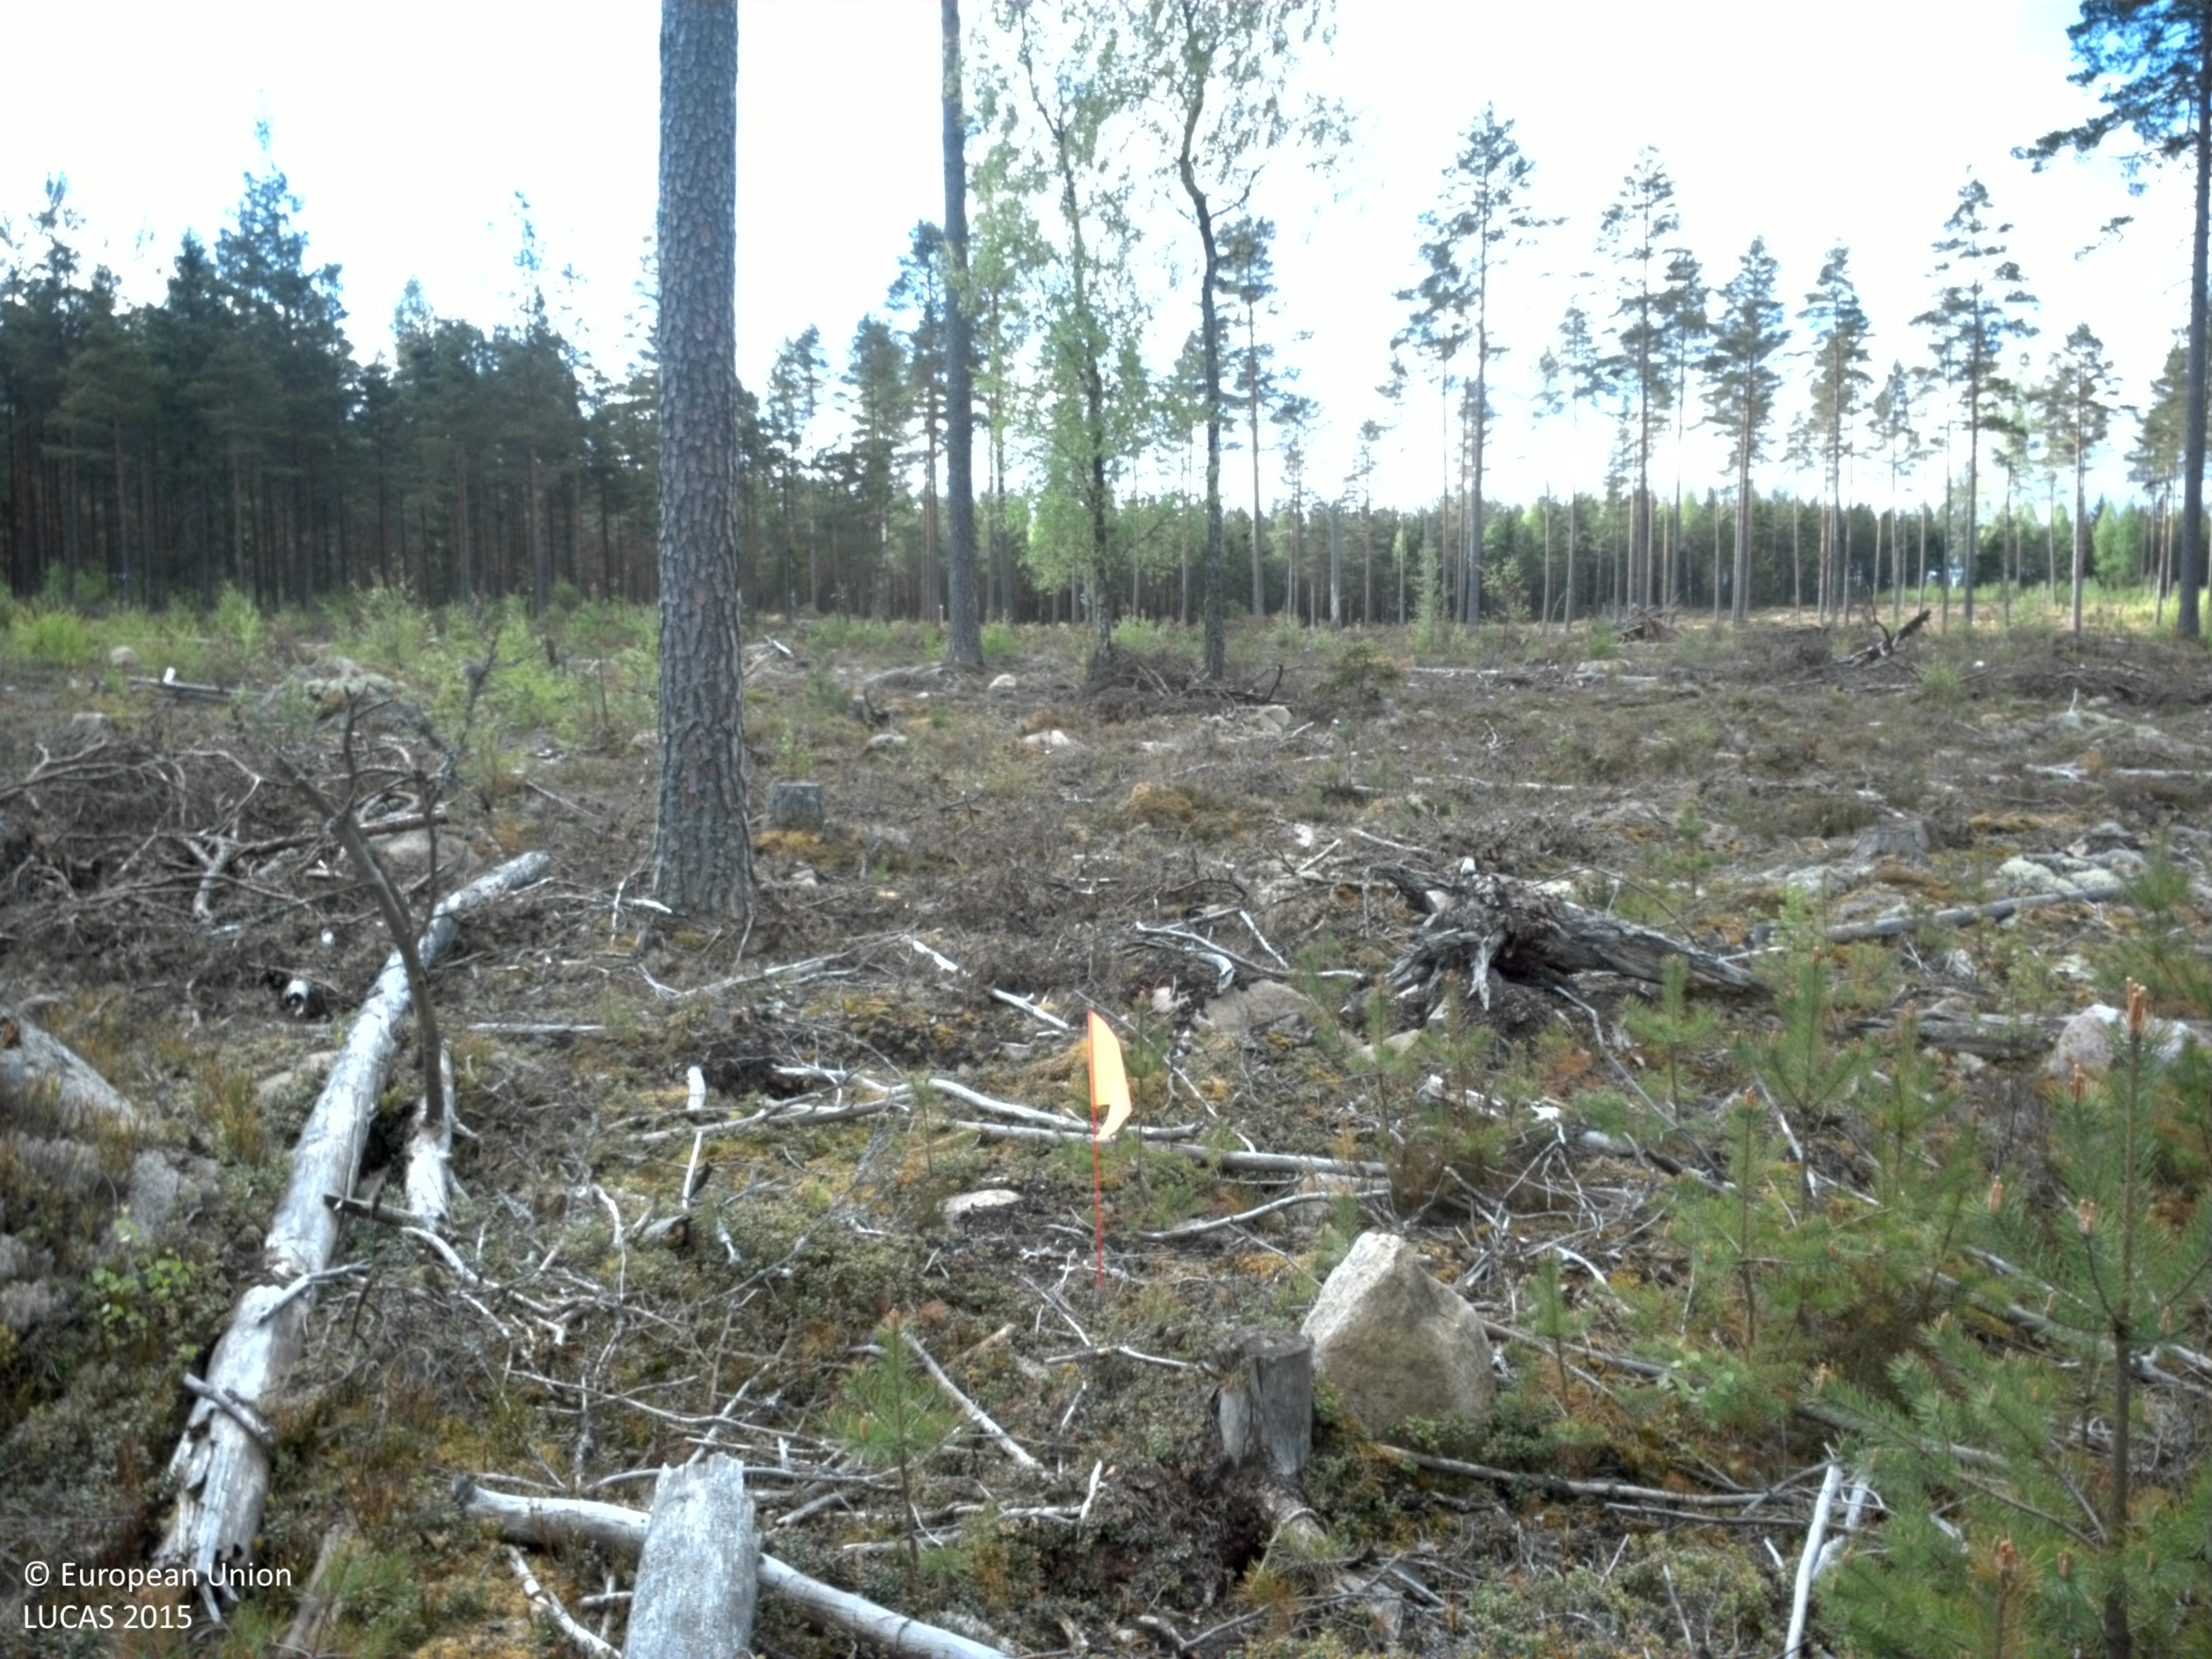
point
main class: Woodland
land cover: Pine dominated coniferous woodland
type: boreal forest
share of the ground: 25 - 50 %
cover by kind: coniferous forest trees 40 %, shrubs 20 %, broadleaved forest trees 10 %, lichens and mosses 10 %
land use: Forestry
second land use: Amenities, museums, leisure
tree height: > 5 m
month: May
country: SE
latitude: 56.7625
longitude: 15.3147
